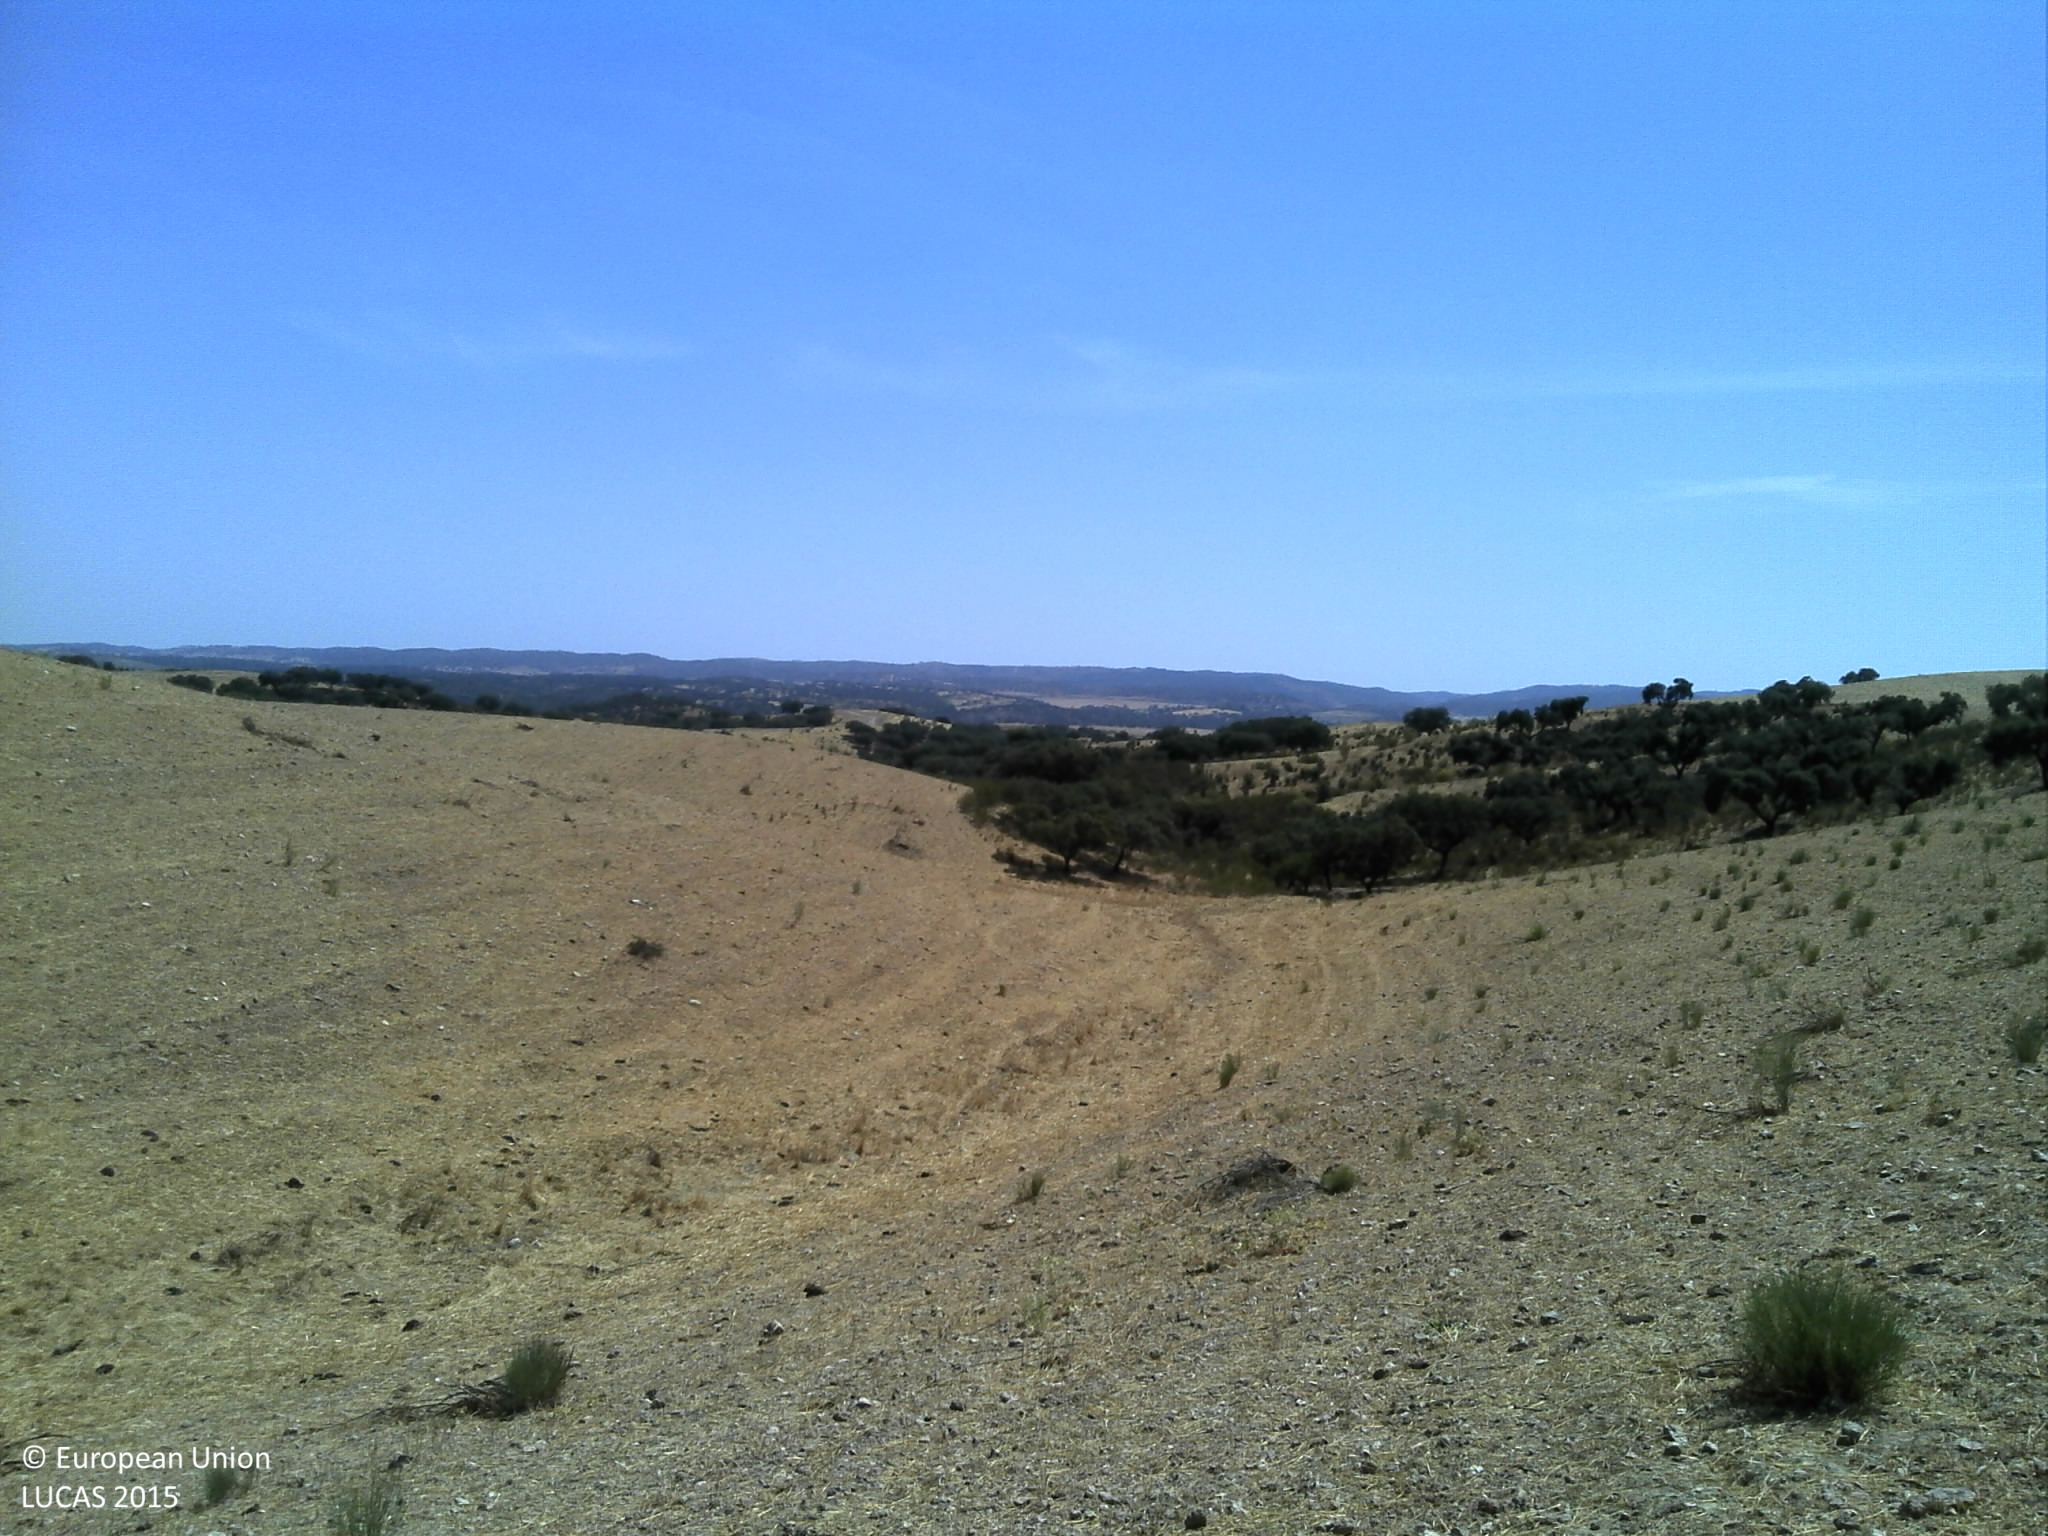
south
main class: Cropland
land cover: Oats
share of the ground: < 10 %
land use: Agriculture (excluding fallow land and kitchen gardens)
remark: Harvested field
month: July
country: PT
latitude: 38.4157
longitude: -7.6333
